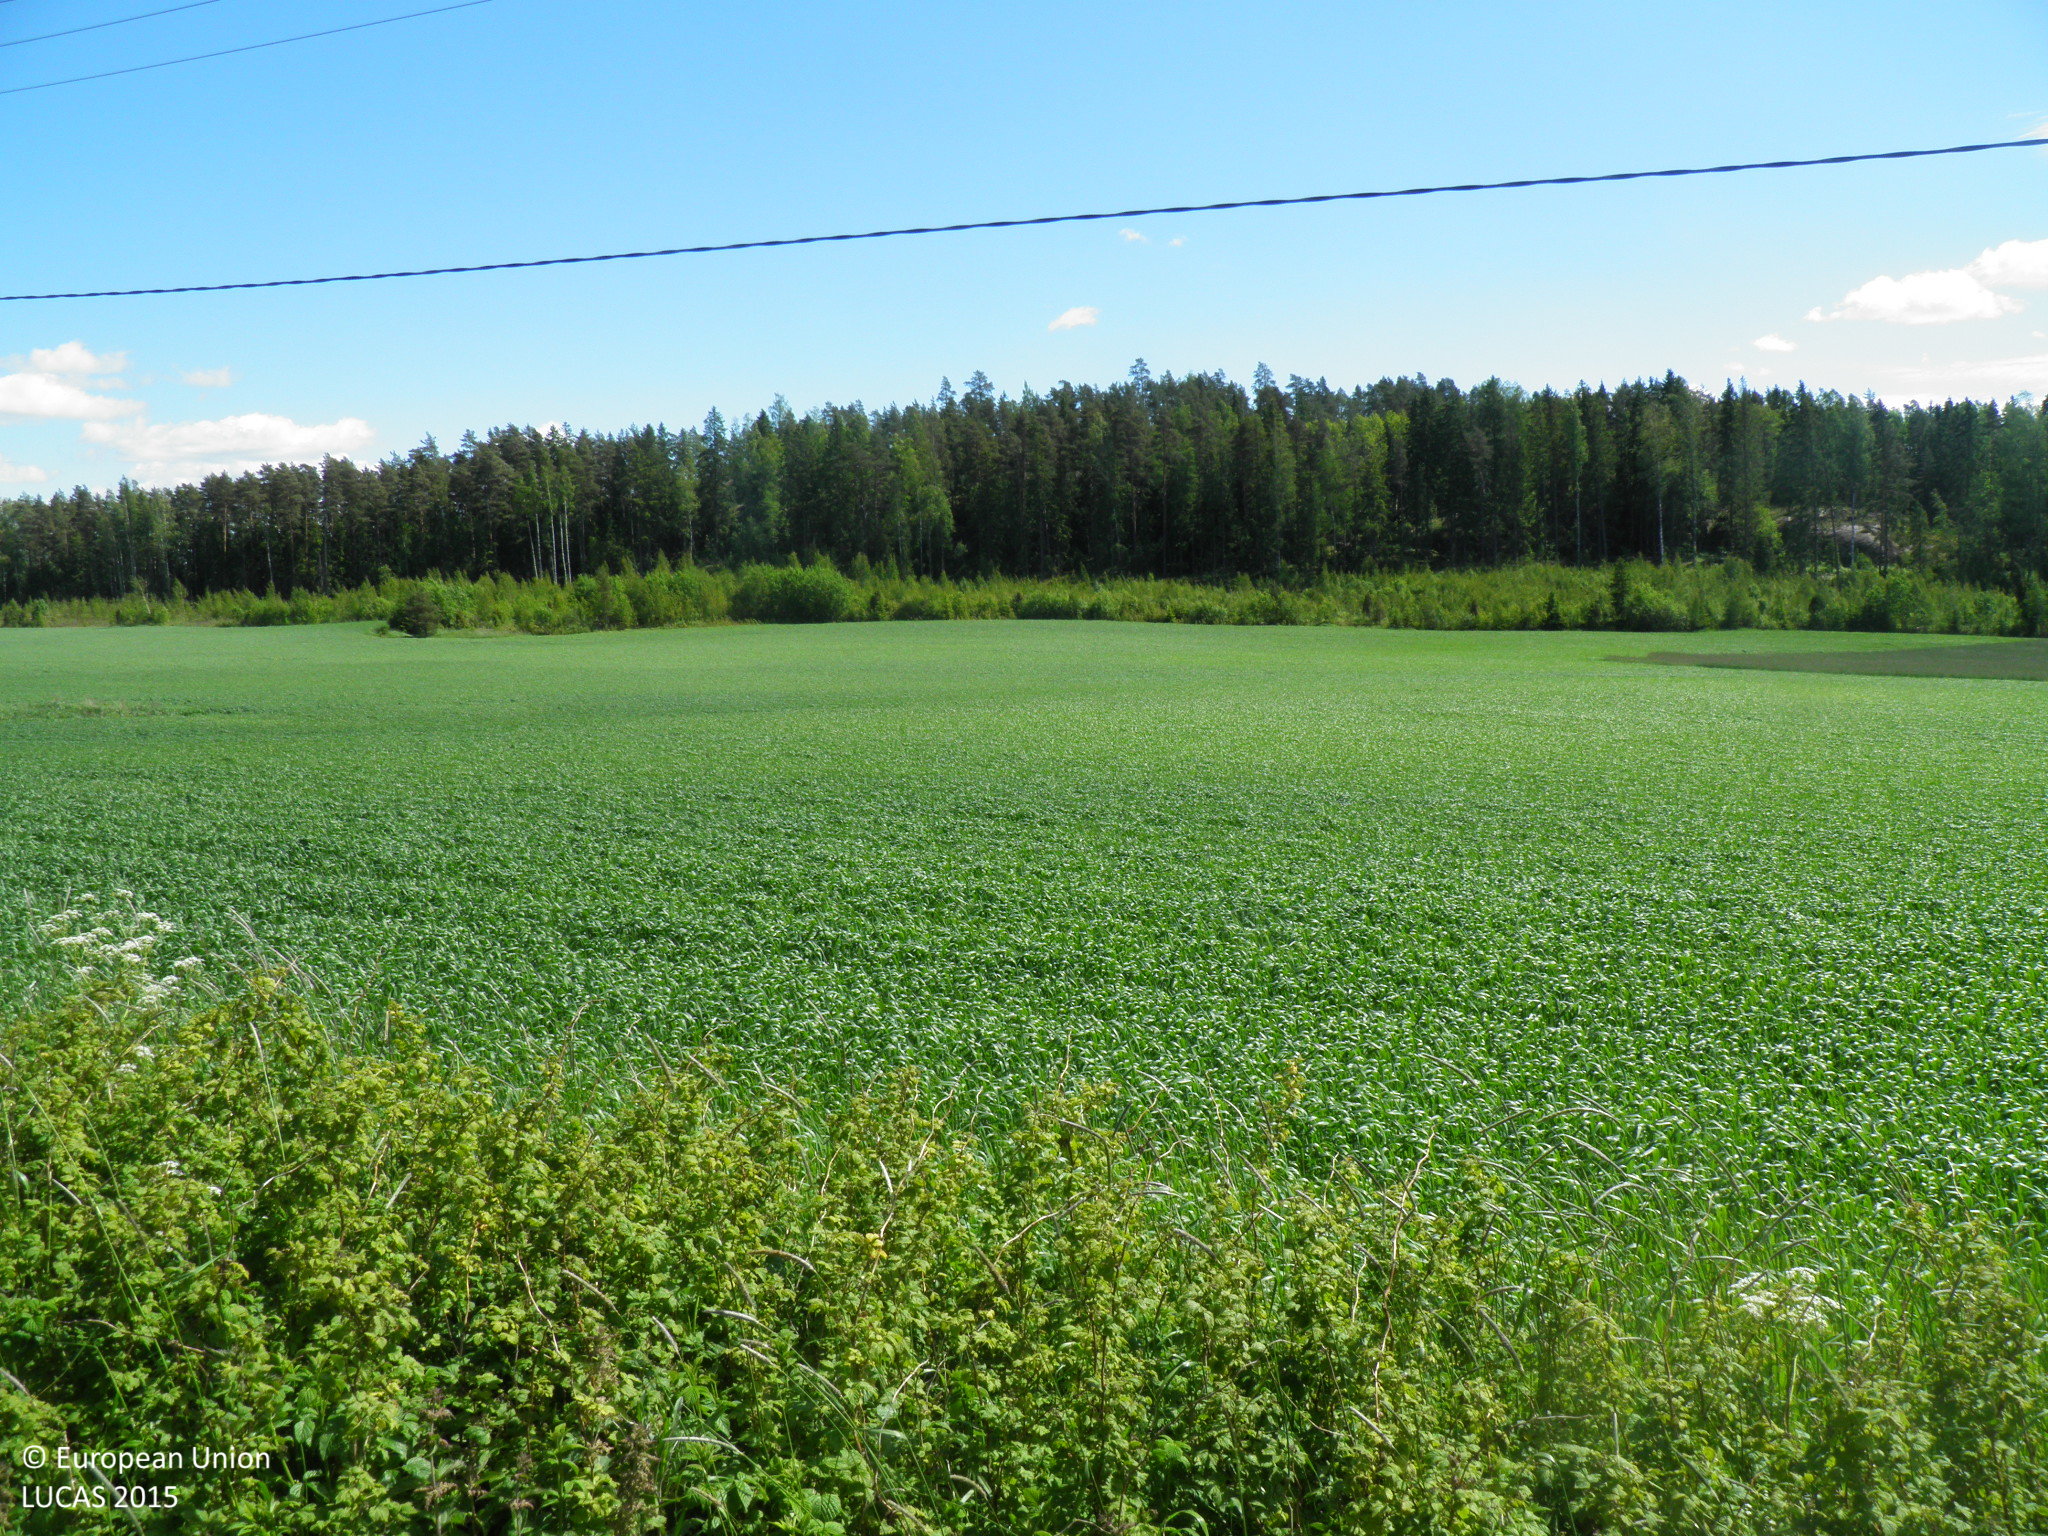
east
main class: Cropland
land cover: Common wheat
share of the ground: > 75 %
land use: Agriculture (excluding fallow land and kitchen gardens)
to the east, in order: Common wheat; Ditches and canals; Broadleaved woodland; Spruce dominated coniferous woodland; Spruce dominated mixed woodland
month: June
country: FI
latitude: 60.3522
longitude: 22.7061
